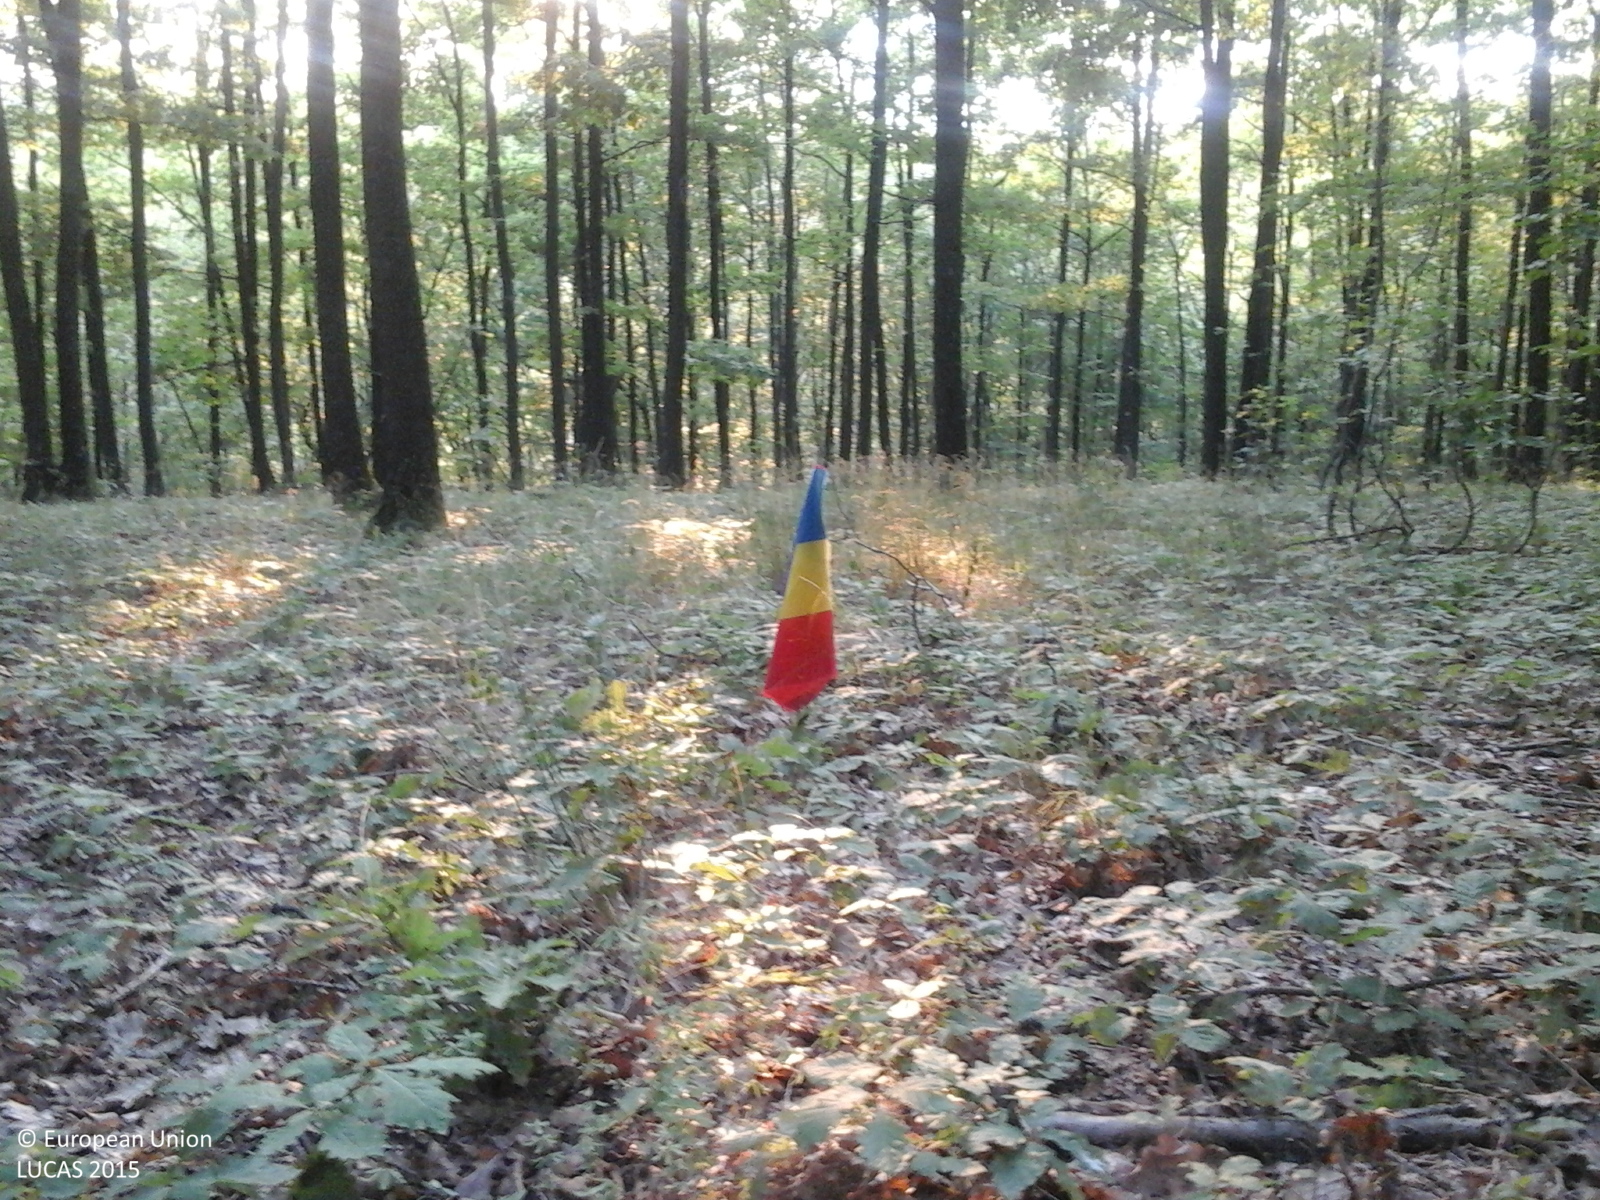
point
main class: Woodland
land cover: Broadleaved woodland
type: acidophilous oak and oak-birch forest
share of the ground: > 75 %
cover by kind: broadleaved forest trees 100 %
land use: Forestry
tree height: > 5 m
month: July
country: RO
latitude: 44.8469
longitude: 24.7428
